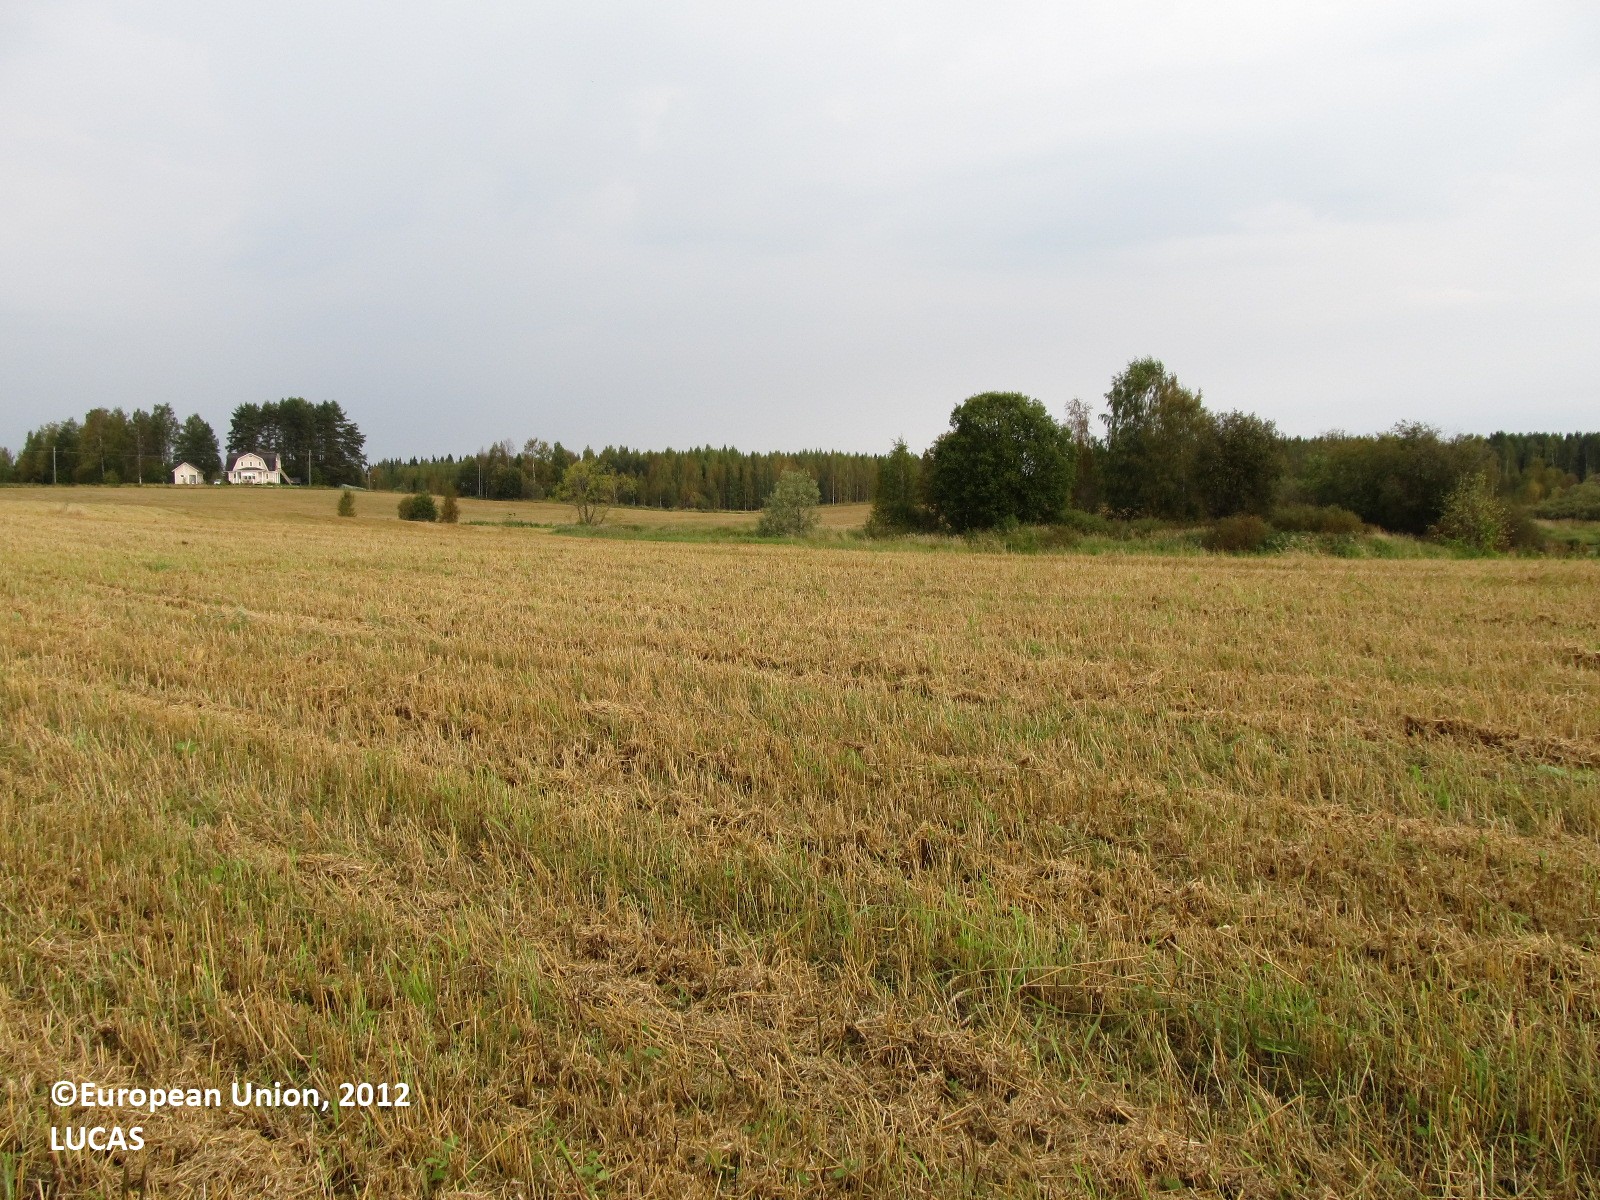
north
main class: Cropland
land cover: Common wheat
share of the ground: 50 - 75 %
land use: Agriculture (excluding fallow land and kitchen gardens)
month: September
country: FI
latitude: 63.0115
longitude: 28.2184
